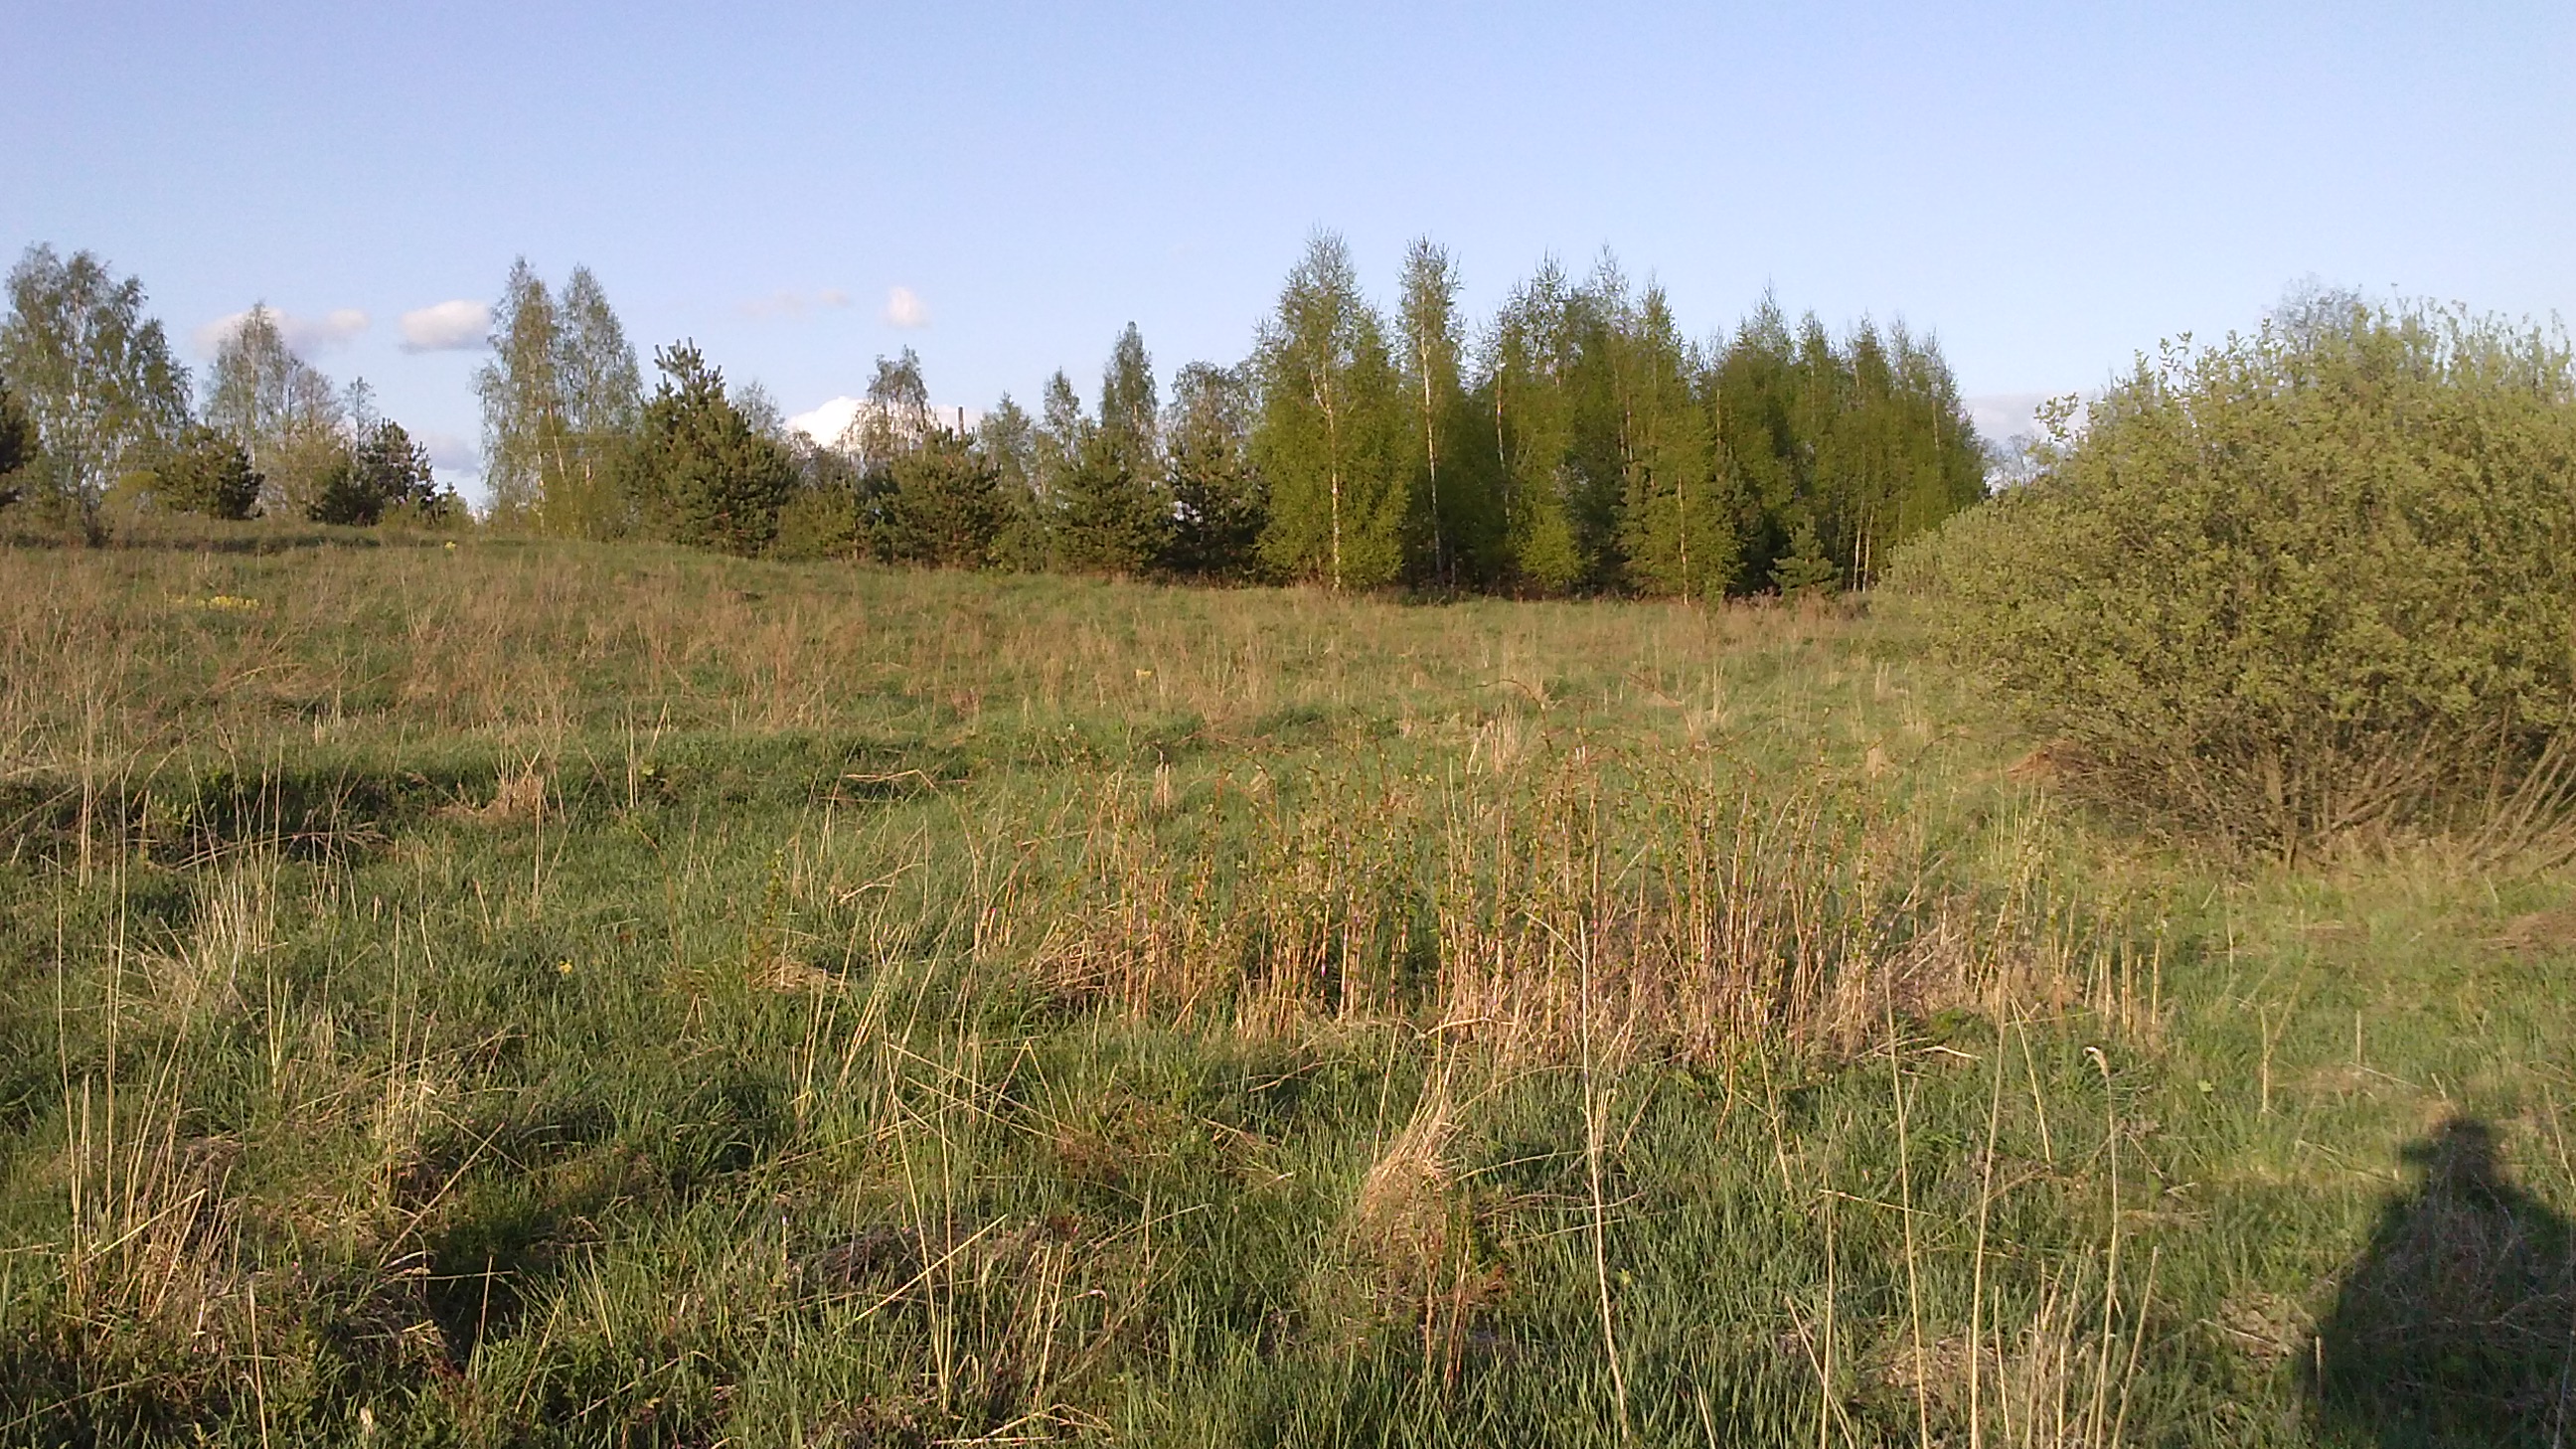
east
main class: Grassland
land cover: Grassland without tree/shrub cover
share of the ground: > 75 %
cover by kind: herbaceous plants 100 %
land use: Agriculture (excluding fallow land and kitchen gardens)
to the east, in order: Grassland without tree/shrub cover; Grassland with sparse tree/shrub cover; Pine dominated mixed woodland; Grassland with sparse tree/shrub cover; Shrubland without tree cover; Paved roads, cycling and walking lanes; Electric lines; Paved roads, cycling and walking lanes; Shrubland without tree cover; Broadleaved woodland; Spontaneously vegetated surfaces; Inland fresh water bodies
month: May
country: LV
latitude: 56.1142
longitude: 27.2357
